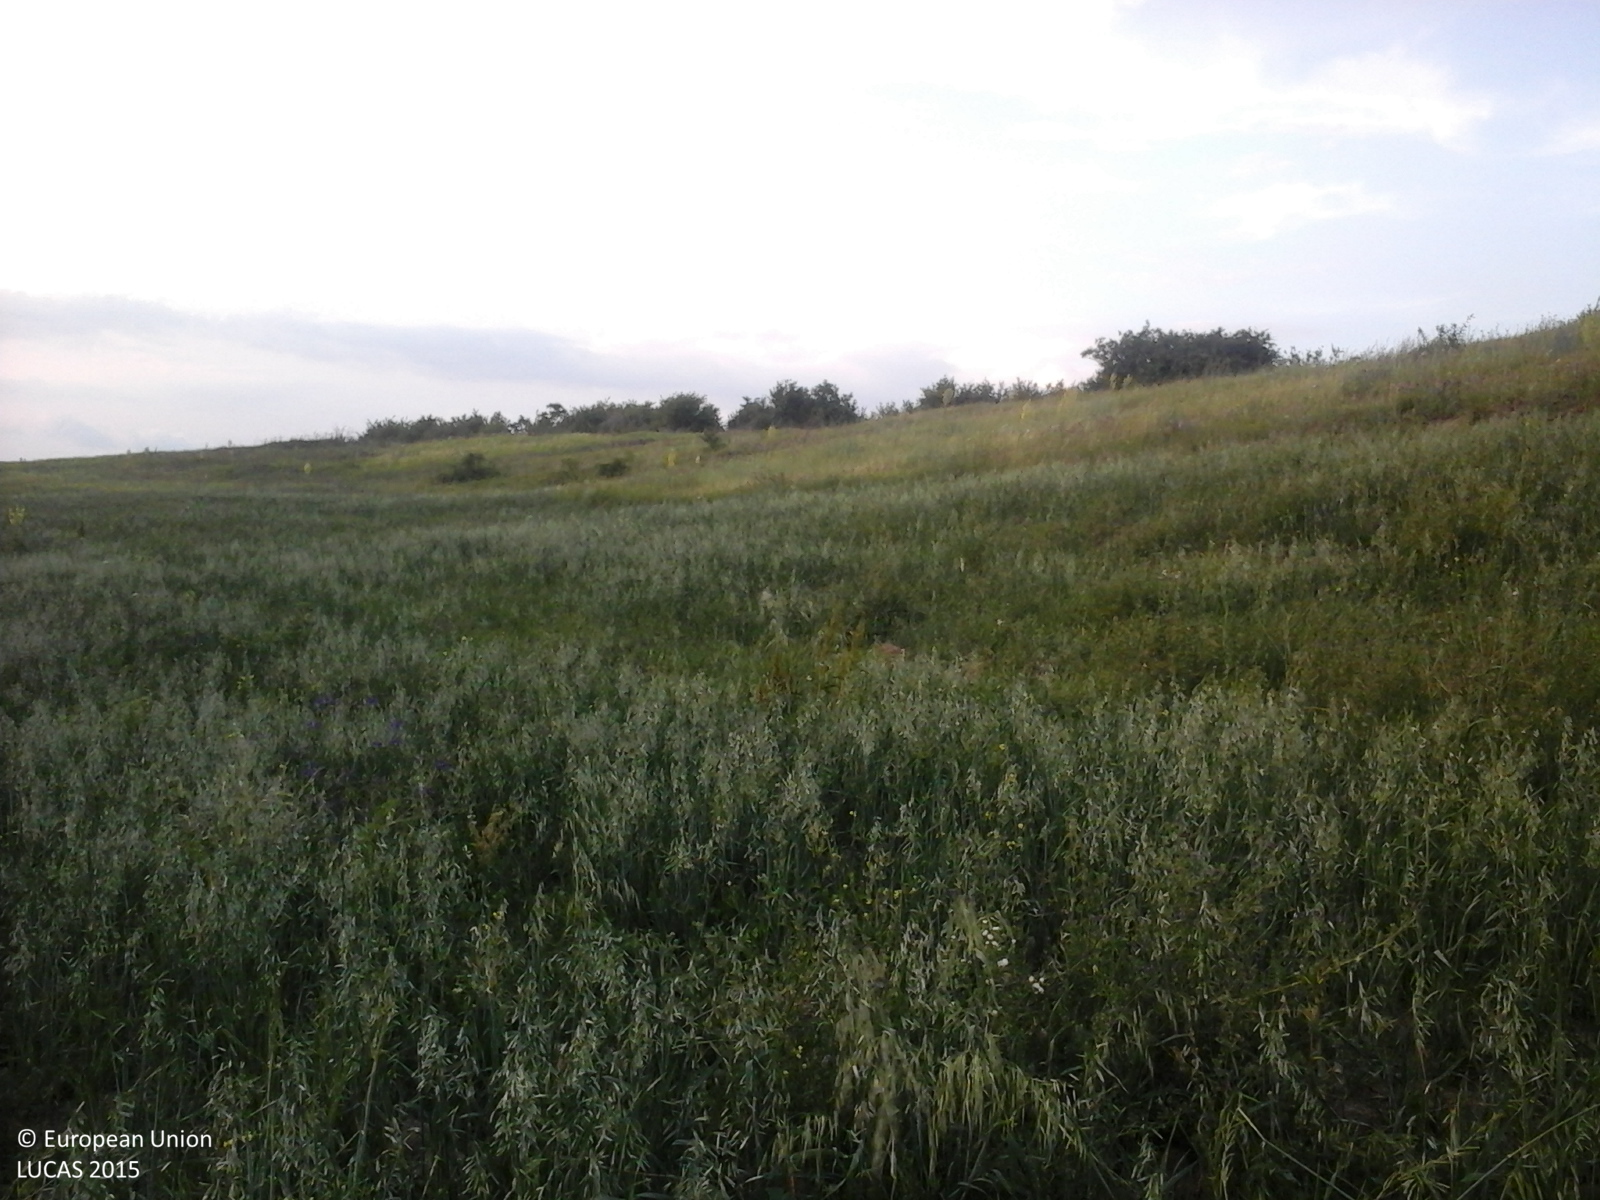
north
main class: Cropland
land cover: Oats
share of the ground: > 75 %
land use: Agriculture (excluding fallow land and kitchen gardens)
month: June
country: RO
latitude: 46.6822
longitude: 27.4870
